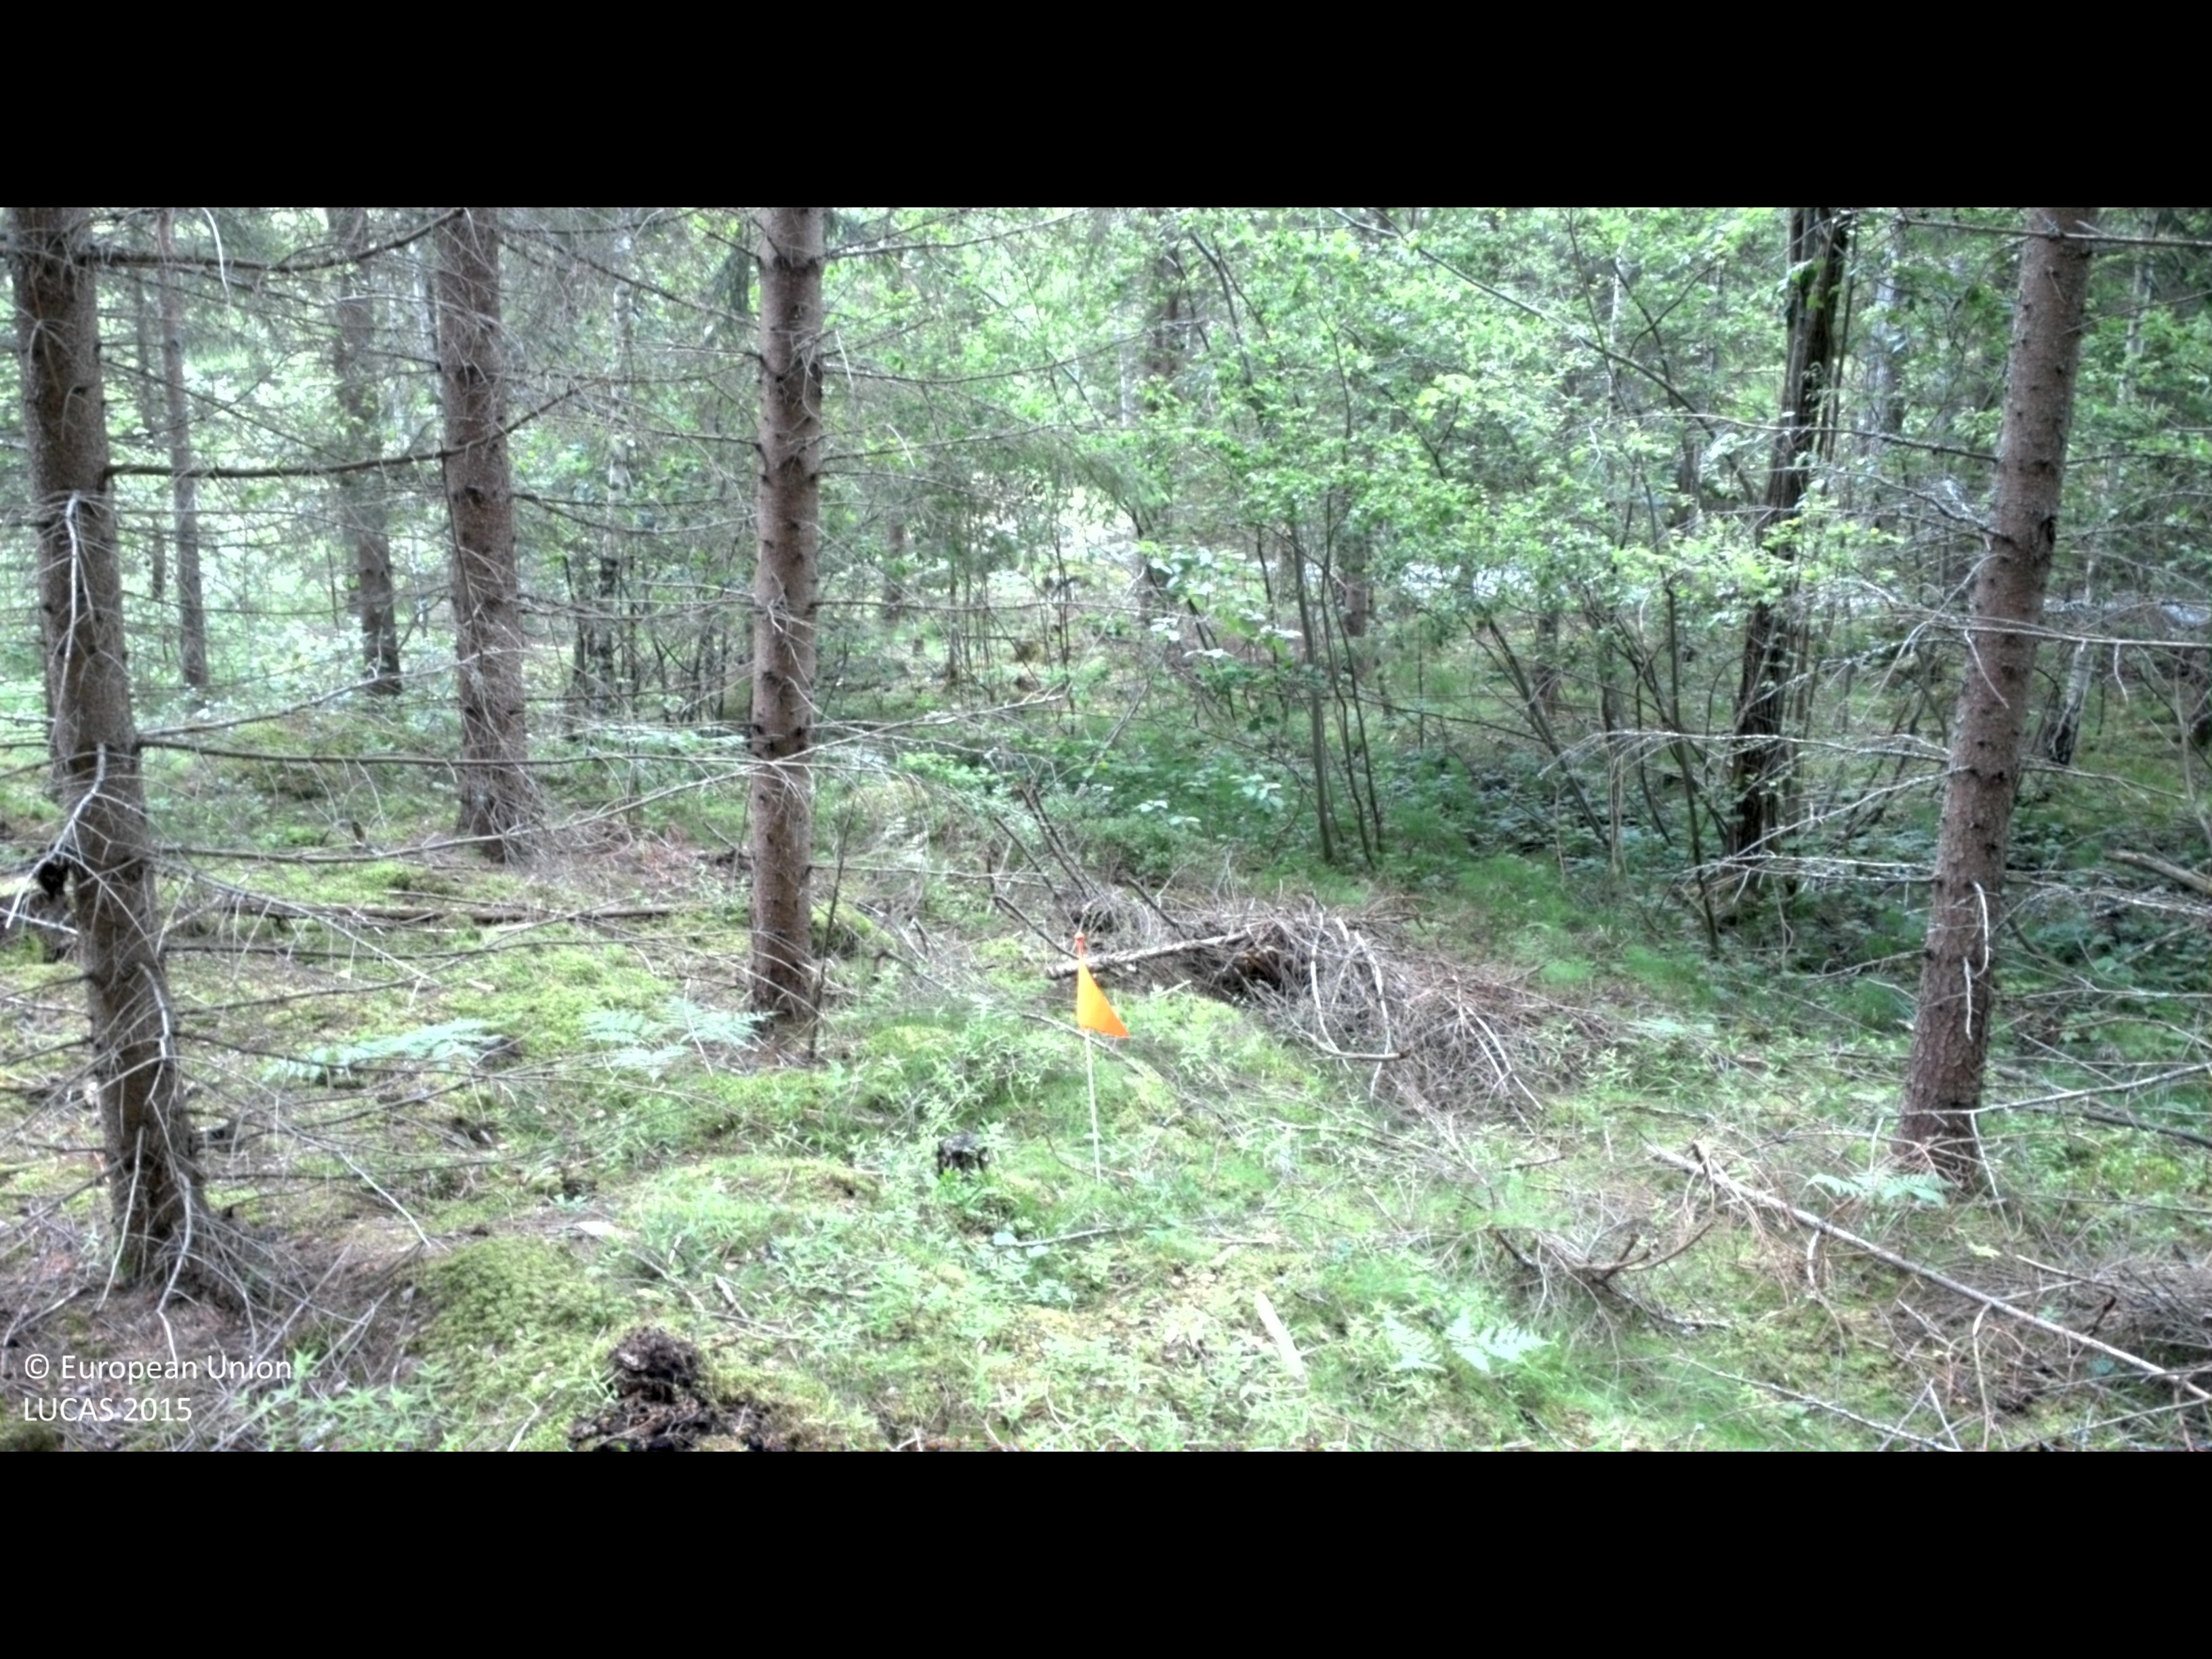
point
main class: Woodland
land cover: Spruce dominated mixed woodland
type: boreal forest
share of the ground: > 75 %
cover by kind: coniferous forest trees 60 %, broadleaved forest trees 20 %, shrubs 10 %, lichens and mosses 10 %
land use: Forestry
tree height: > 5 m
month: June
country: SE
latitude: 58.1360
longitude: 16.4680
